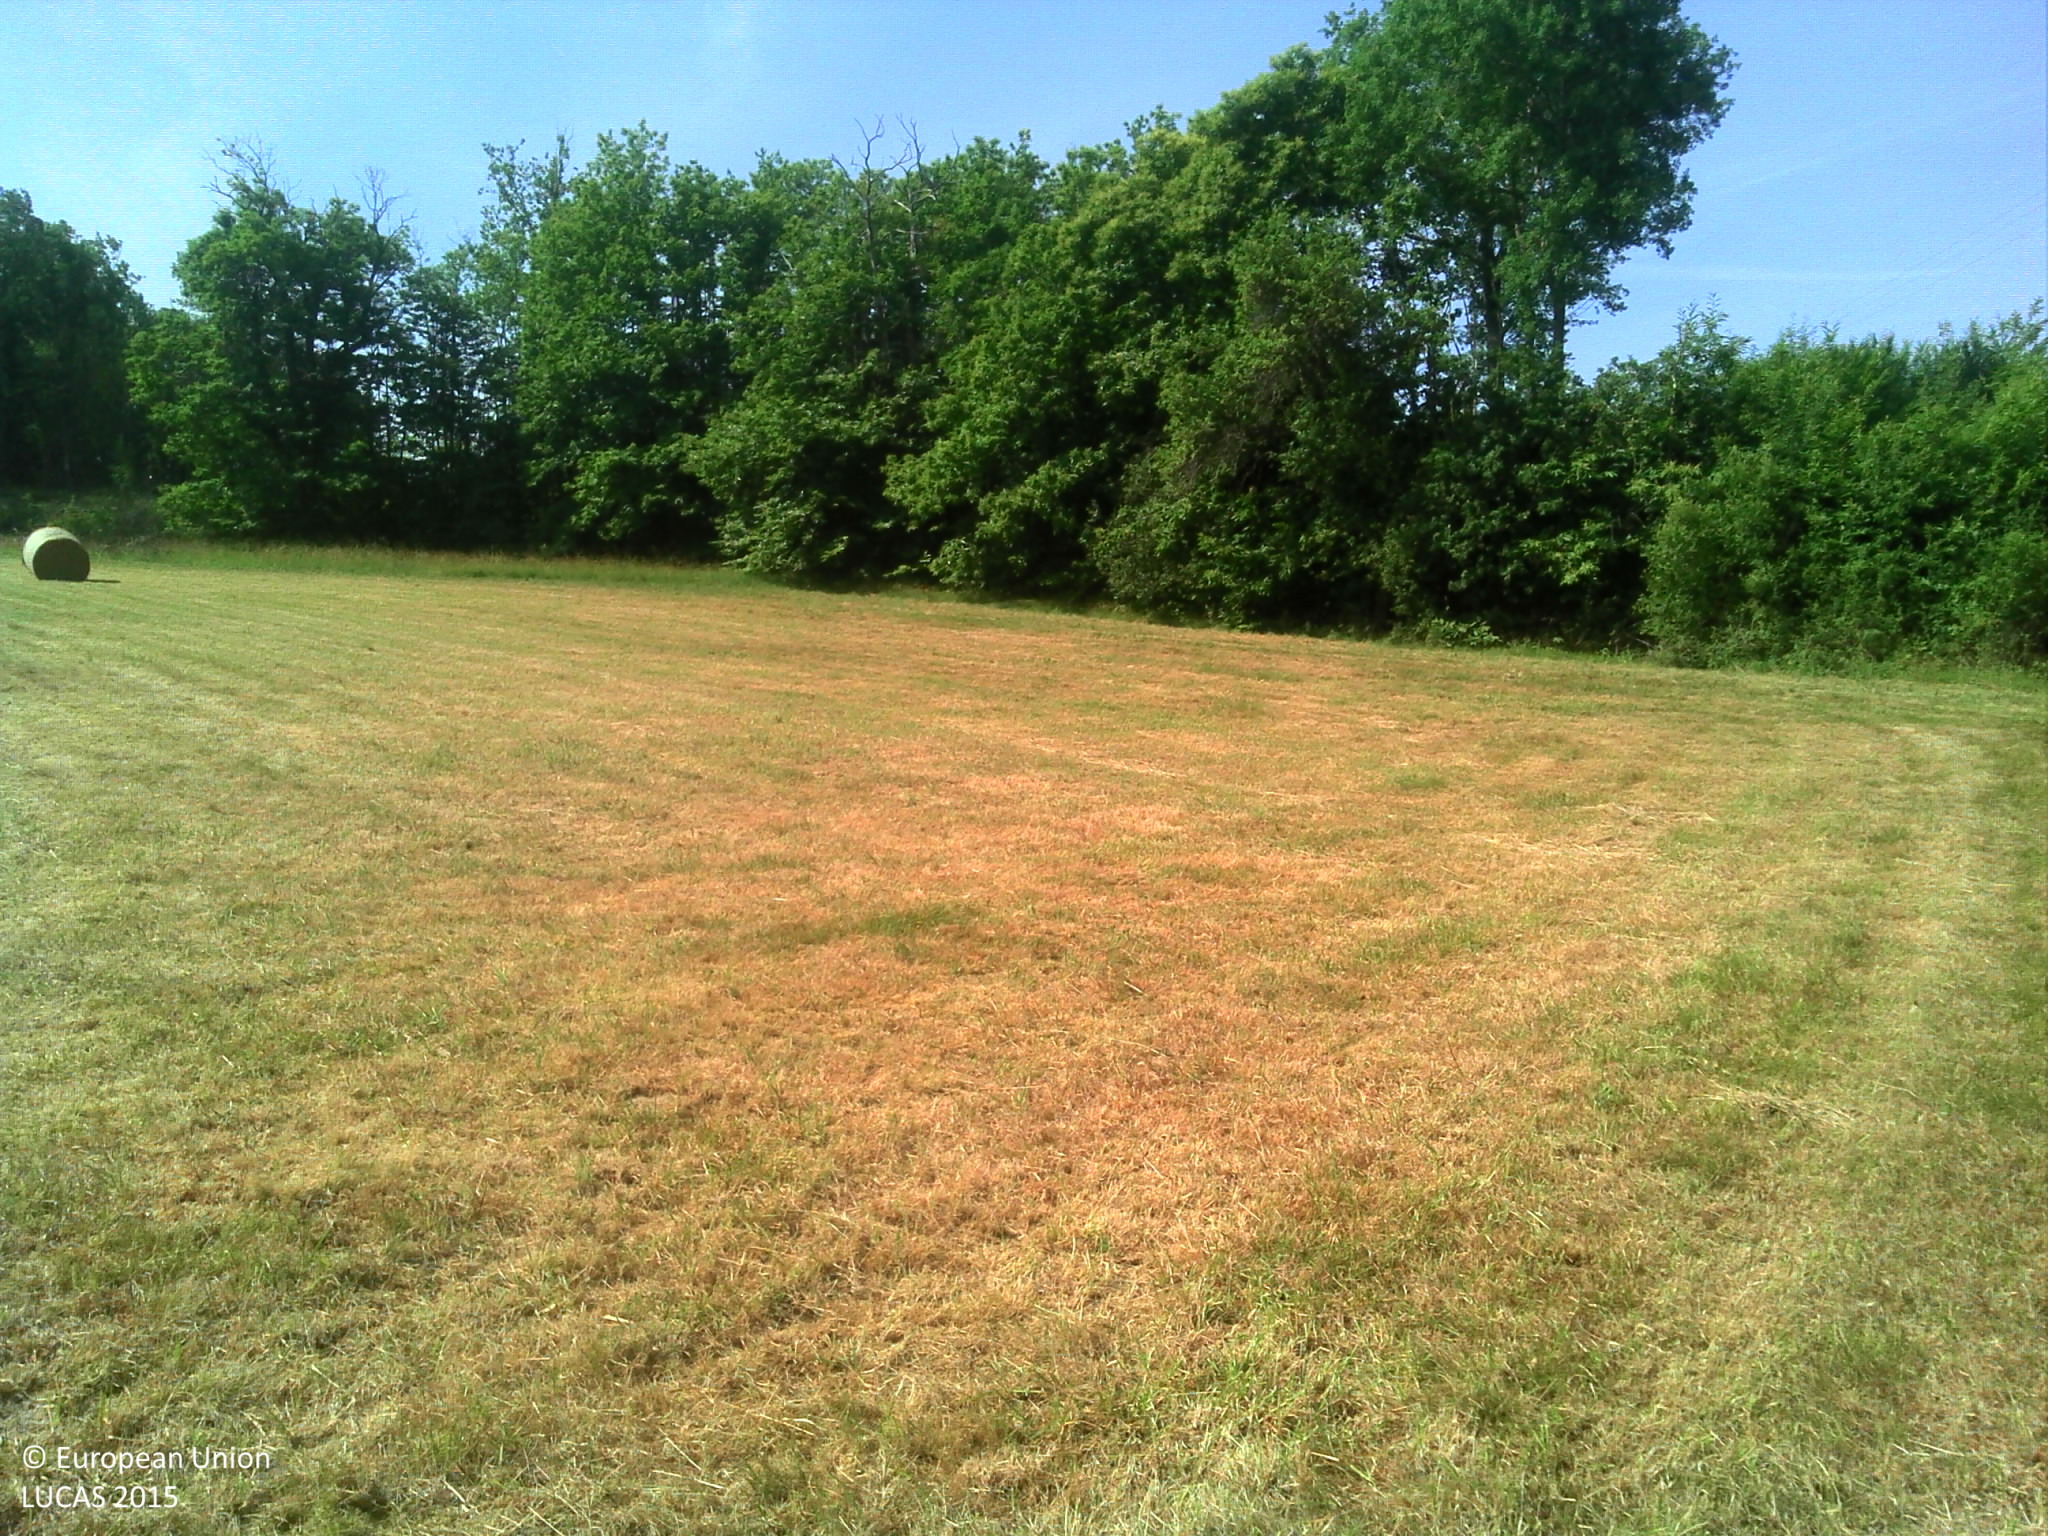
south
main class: Grassland
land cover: Grassland without tree/shrub cover
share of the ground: > 75 %
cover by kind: herbaceous plants 100 %
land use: Agriculture (excluding fallow land and kitchen gardens)
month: June
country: FR
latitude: 43.9624
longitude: 1.6890
